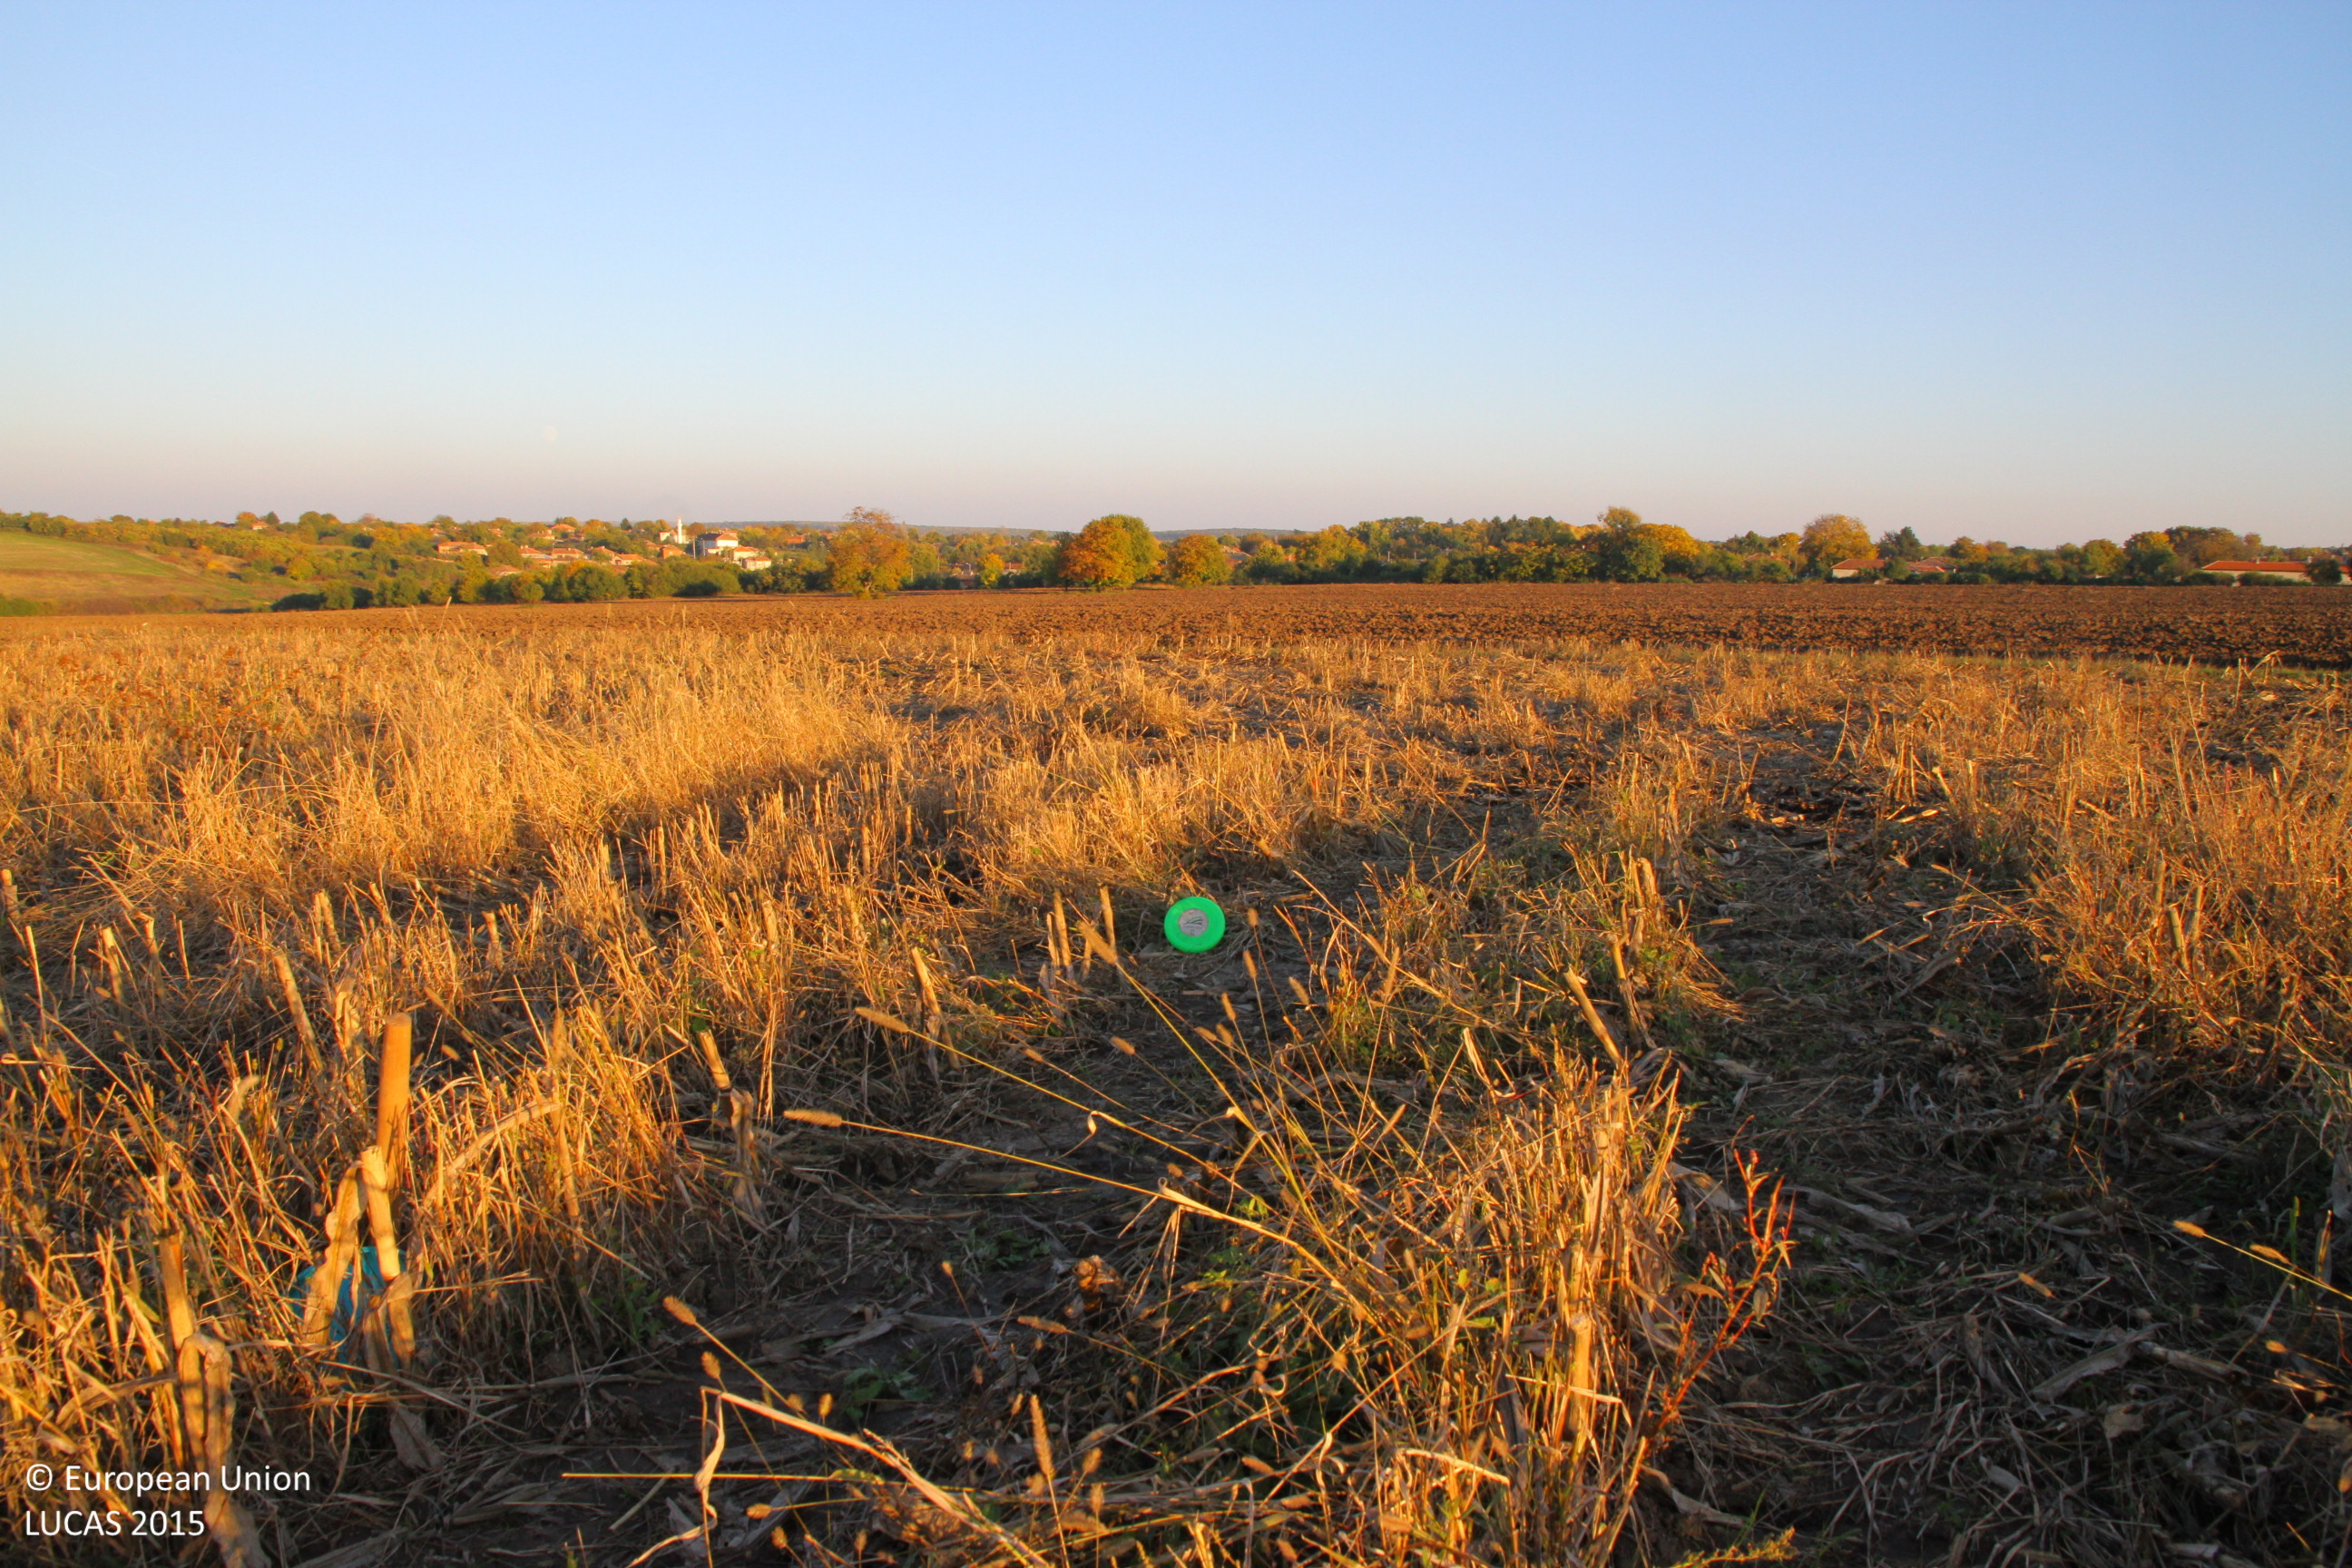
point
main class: Cropland
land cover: Maize
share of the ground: 10 - 25 %
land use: Agriculture (excluding fallow land and kitchen gardens)
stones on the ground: < 10 %
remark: Harvested field
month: October
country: BG
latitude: 43.7069
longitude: 26.4496
